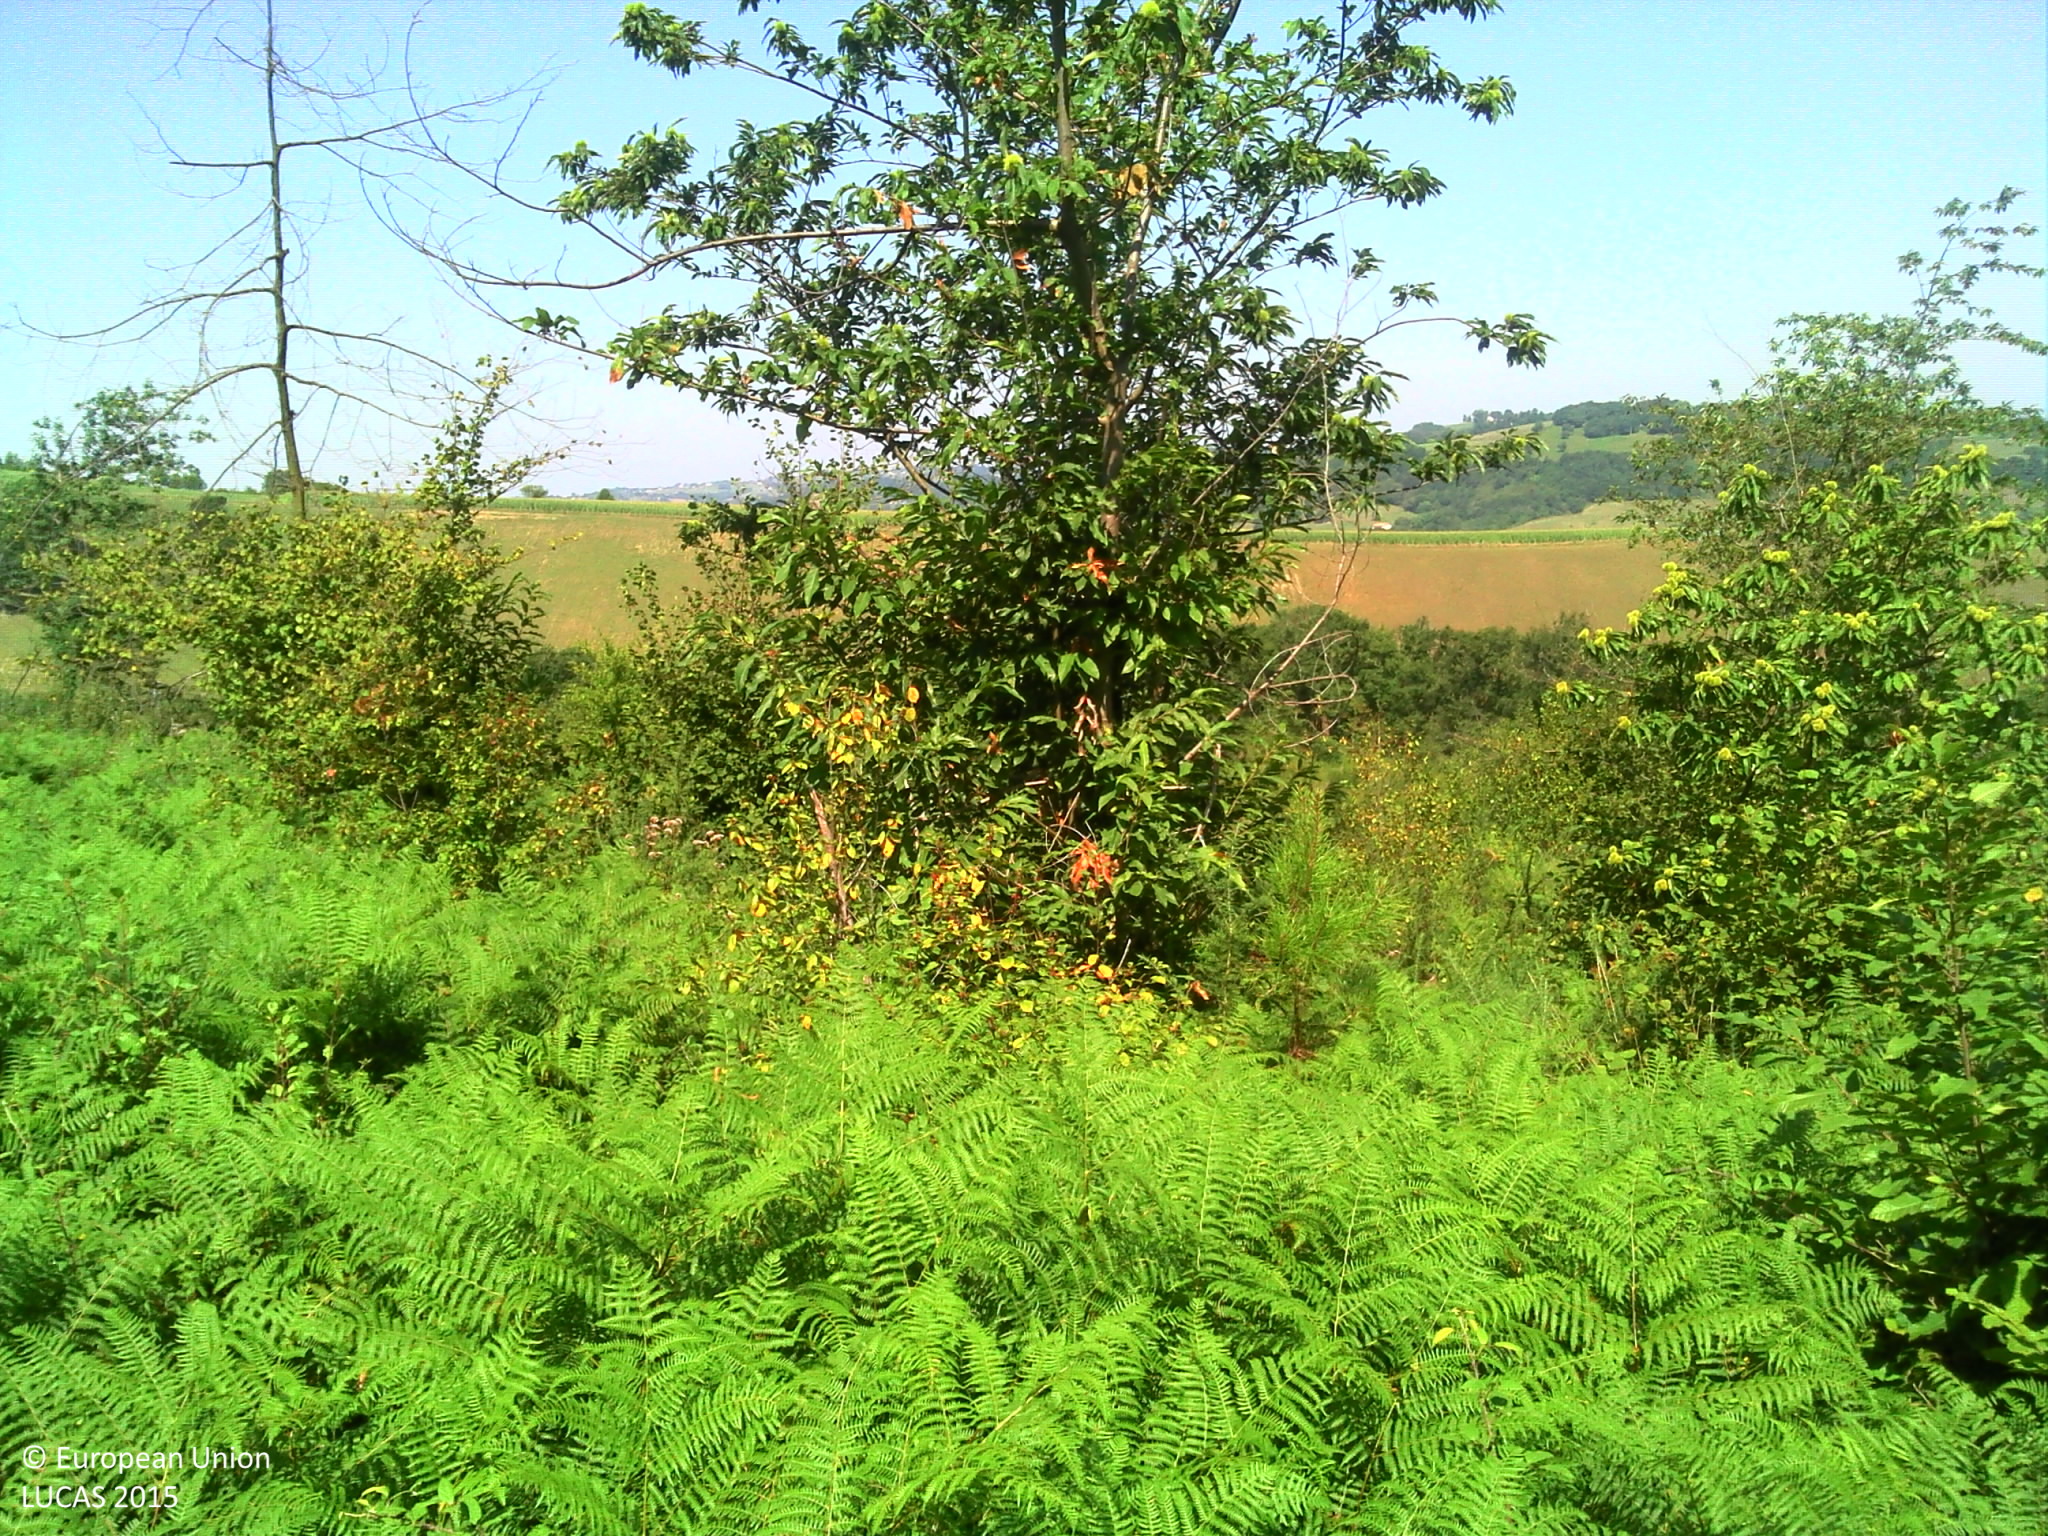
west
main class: Shrubland
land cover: Shrubland with sparse tree cover
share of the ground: > 75 %
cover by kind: herbaceous plants 65 %, shrubs 30 %, broadleaved forest trees 5 %
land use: Forestry
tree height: > 5 m
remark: Clear cut
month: August
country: FR
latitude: 43.4441
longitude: -1.0976
